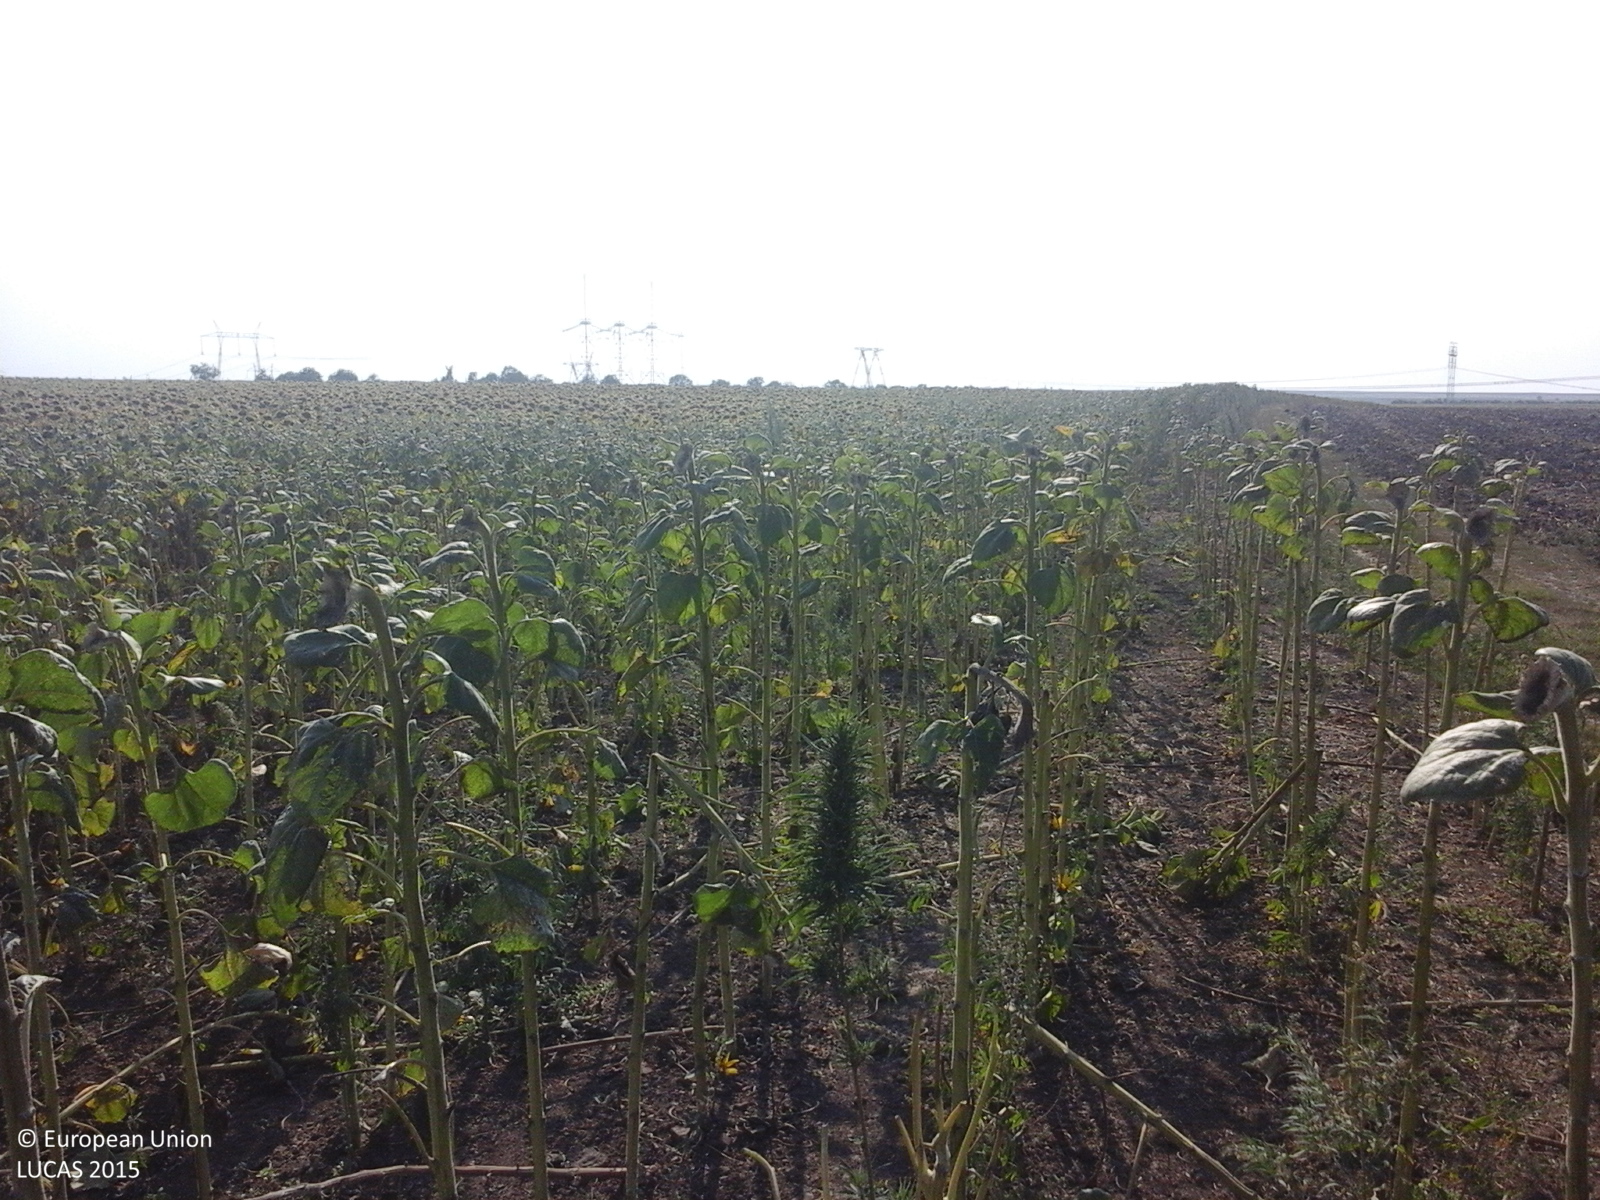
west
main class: Cropland
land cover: Sunflower
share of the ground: > 75 %
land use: Agriculture (excluding fallow land and kitchen gardens)
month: August
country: RO
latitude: 44.0973
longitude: 28.0548
